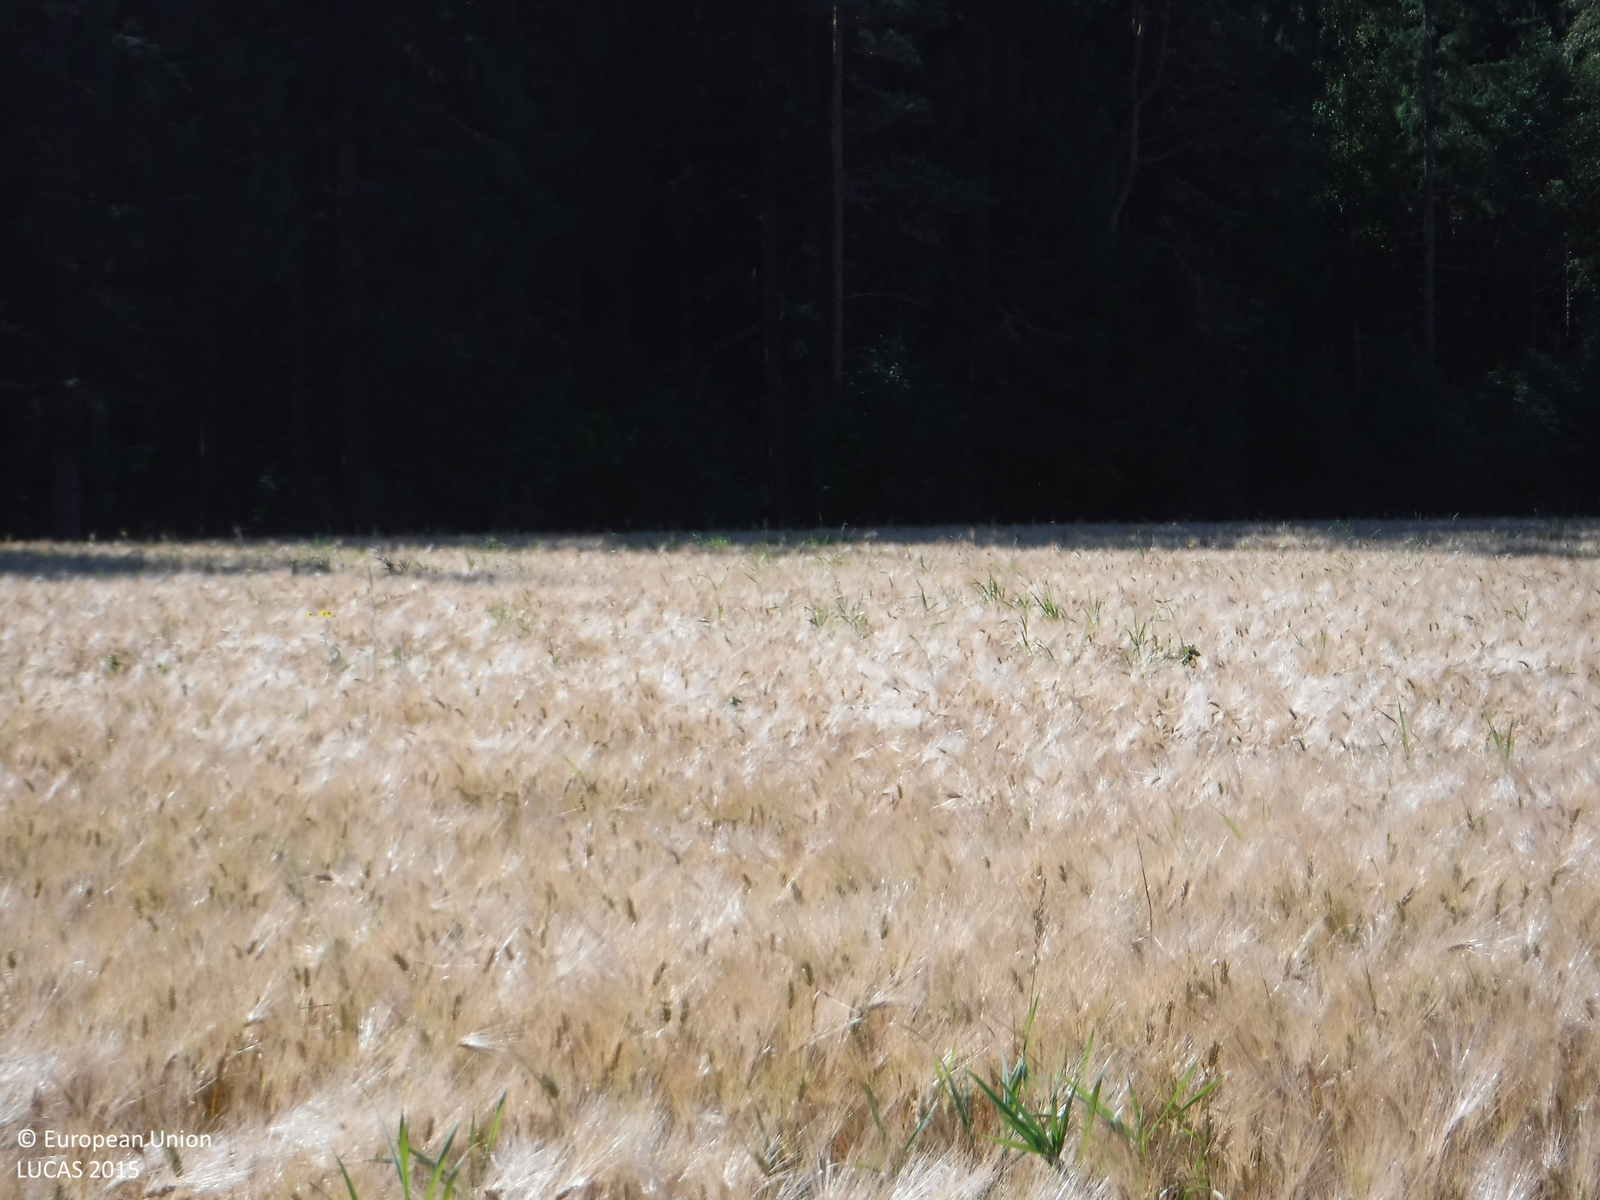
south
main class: Cropland
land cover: Barley
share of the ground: > 75 %
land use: Agriculture (excluding fallow land and kitchen gardens)
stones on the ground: < 10 %
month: August
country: FI
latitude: 61.1297
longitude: 21.7340
